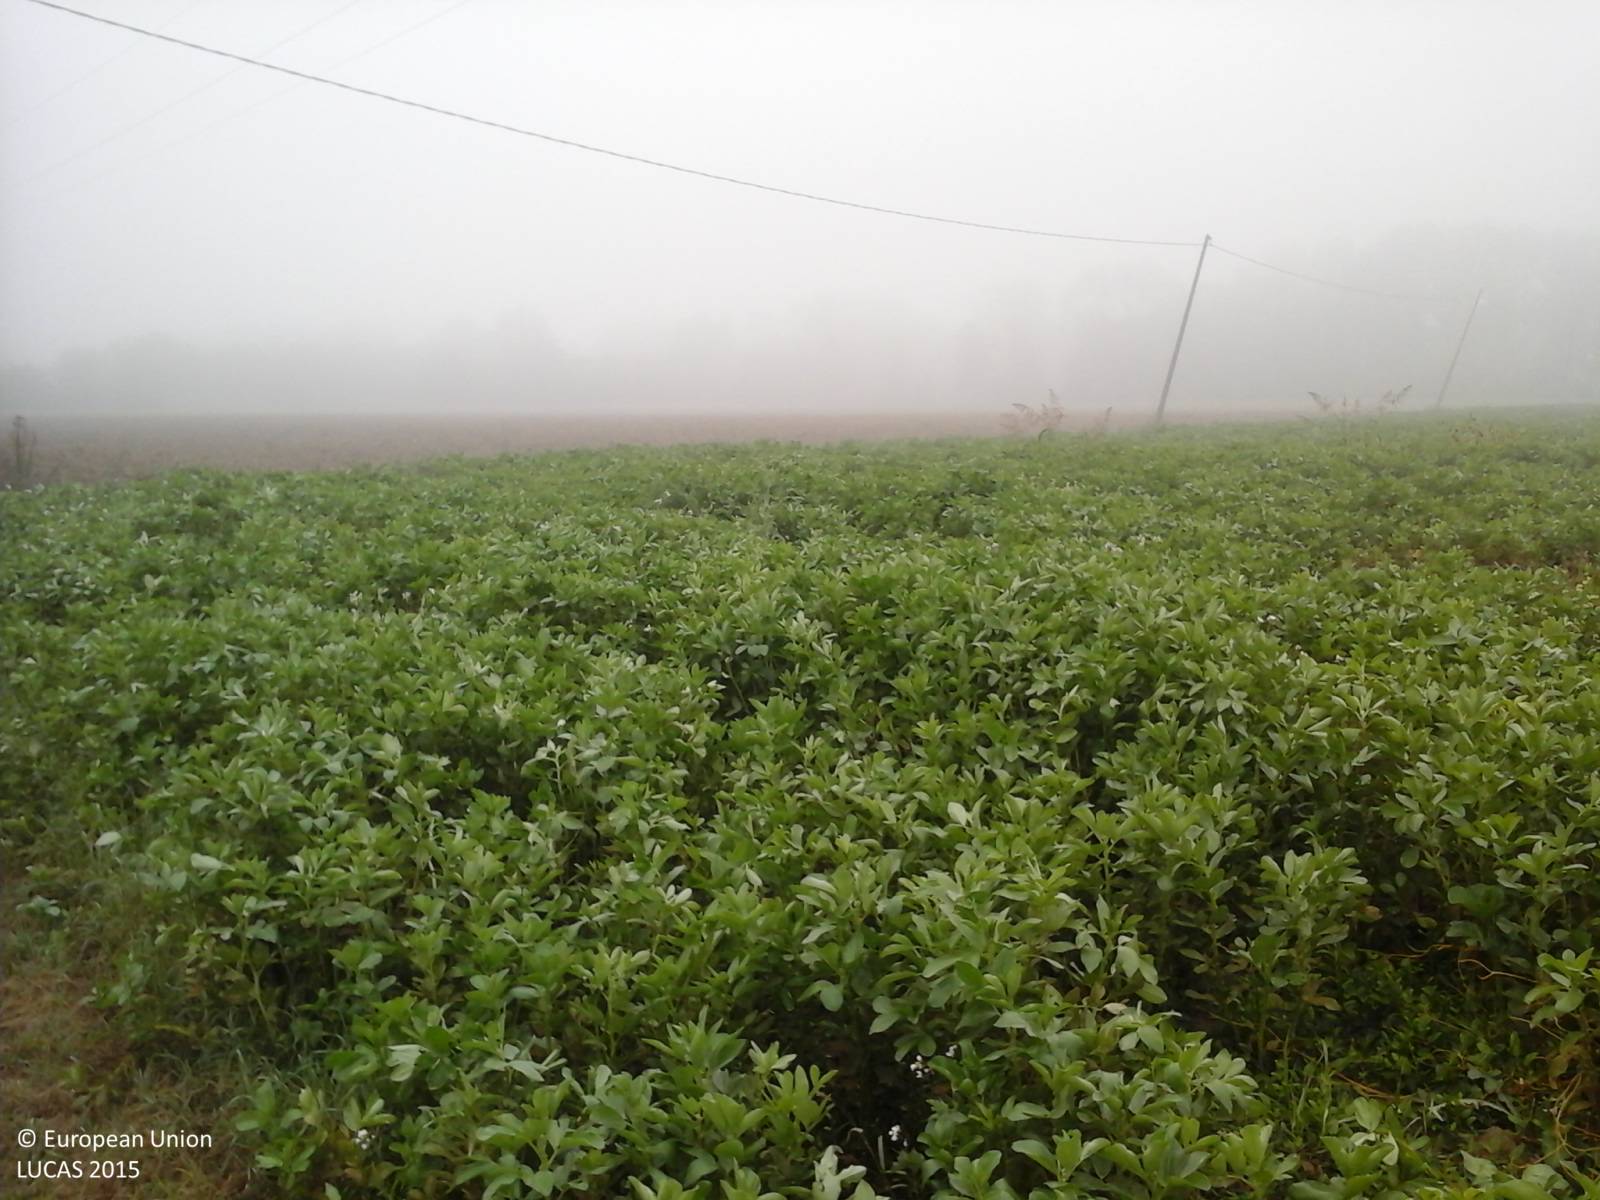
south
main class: Cropland
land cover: Other leguminous and mixtures for fodder
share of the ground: > 75 %
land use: Agriculture (excluding fallow land and kitchen gardens)
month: October
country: IT
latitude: 42.8062
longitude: 12.4016
